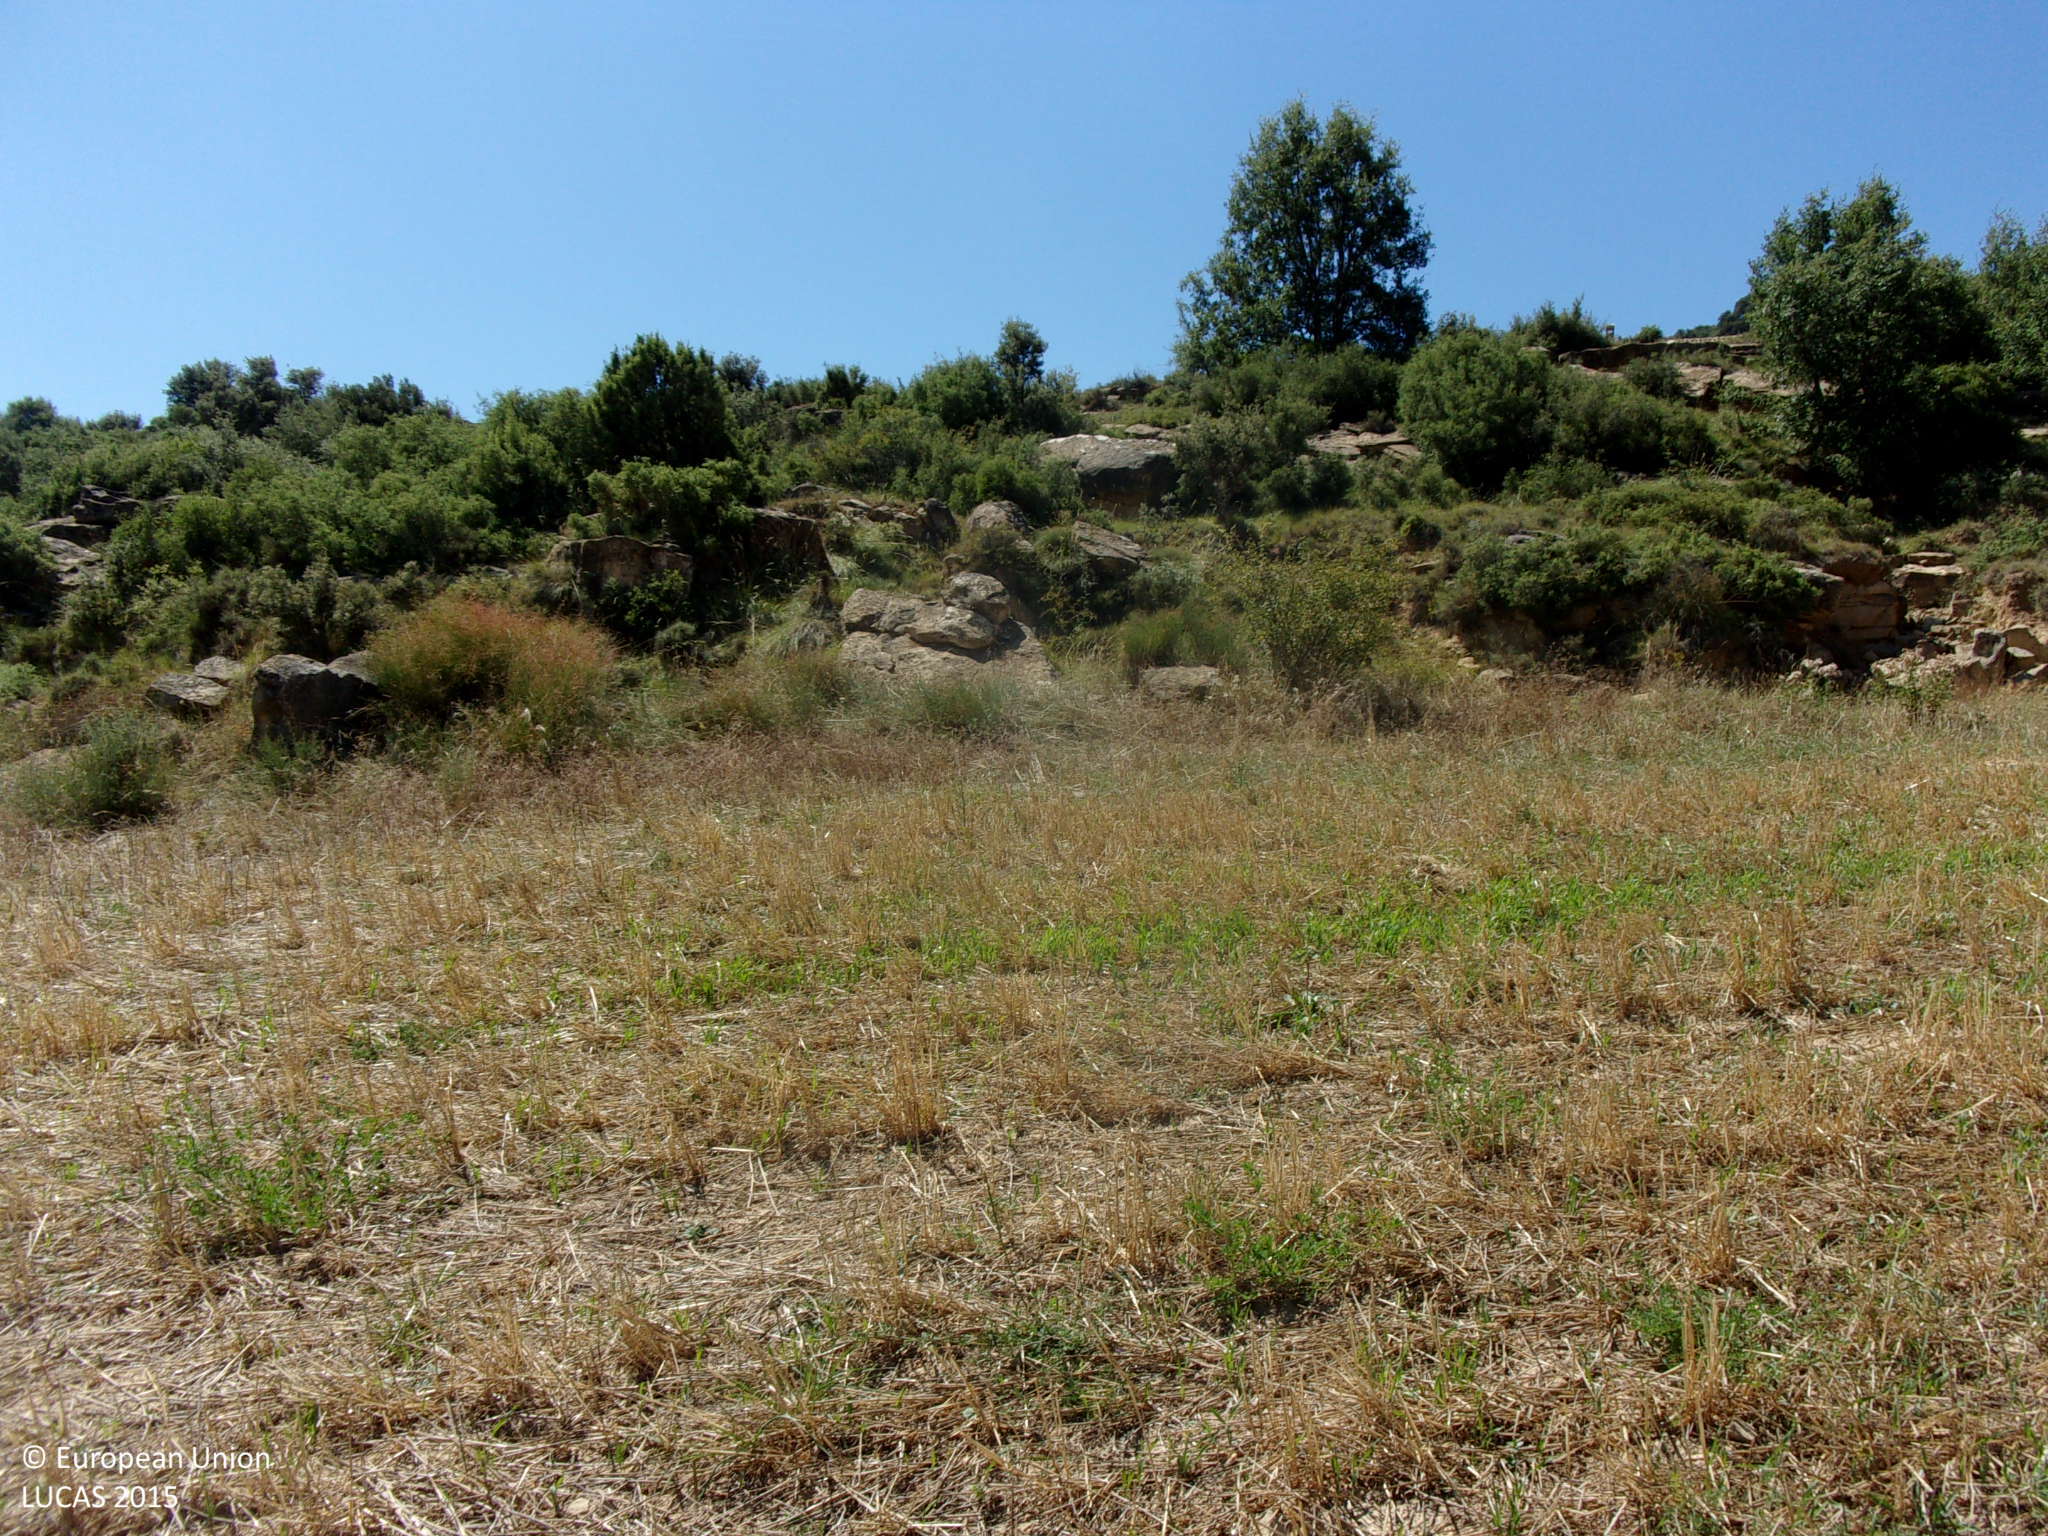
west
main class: Cropland
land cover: Barley
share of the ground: < 10 %
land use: Agriculture (excluding fallow land and kitchen gardens)
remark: Harvested field
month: August
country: ES
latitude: 42.3858
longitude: -1.1200
